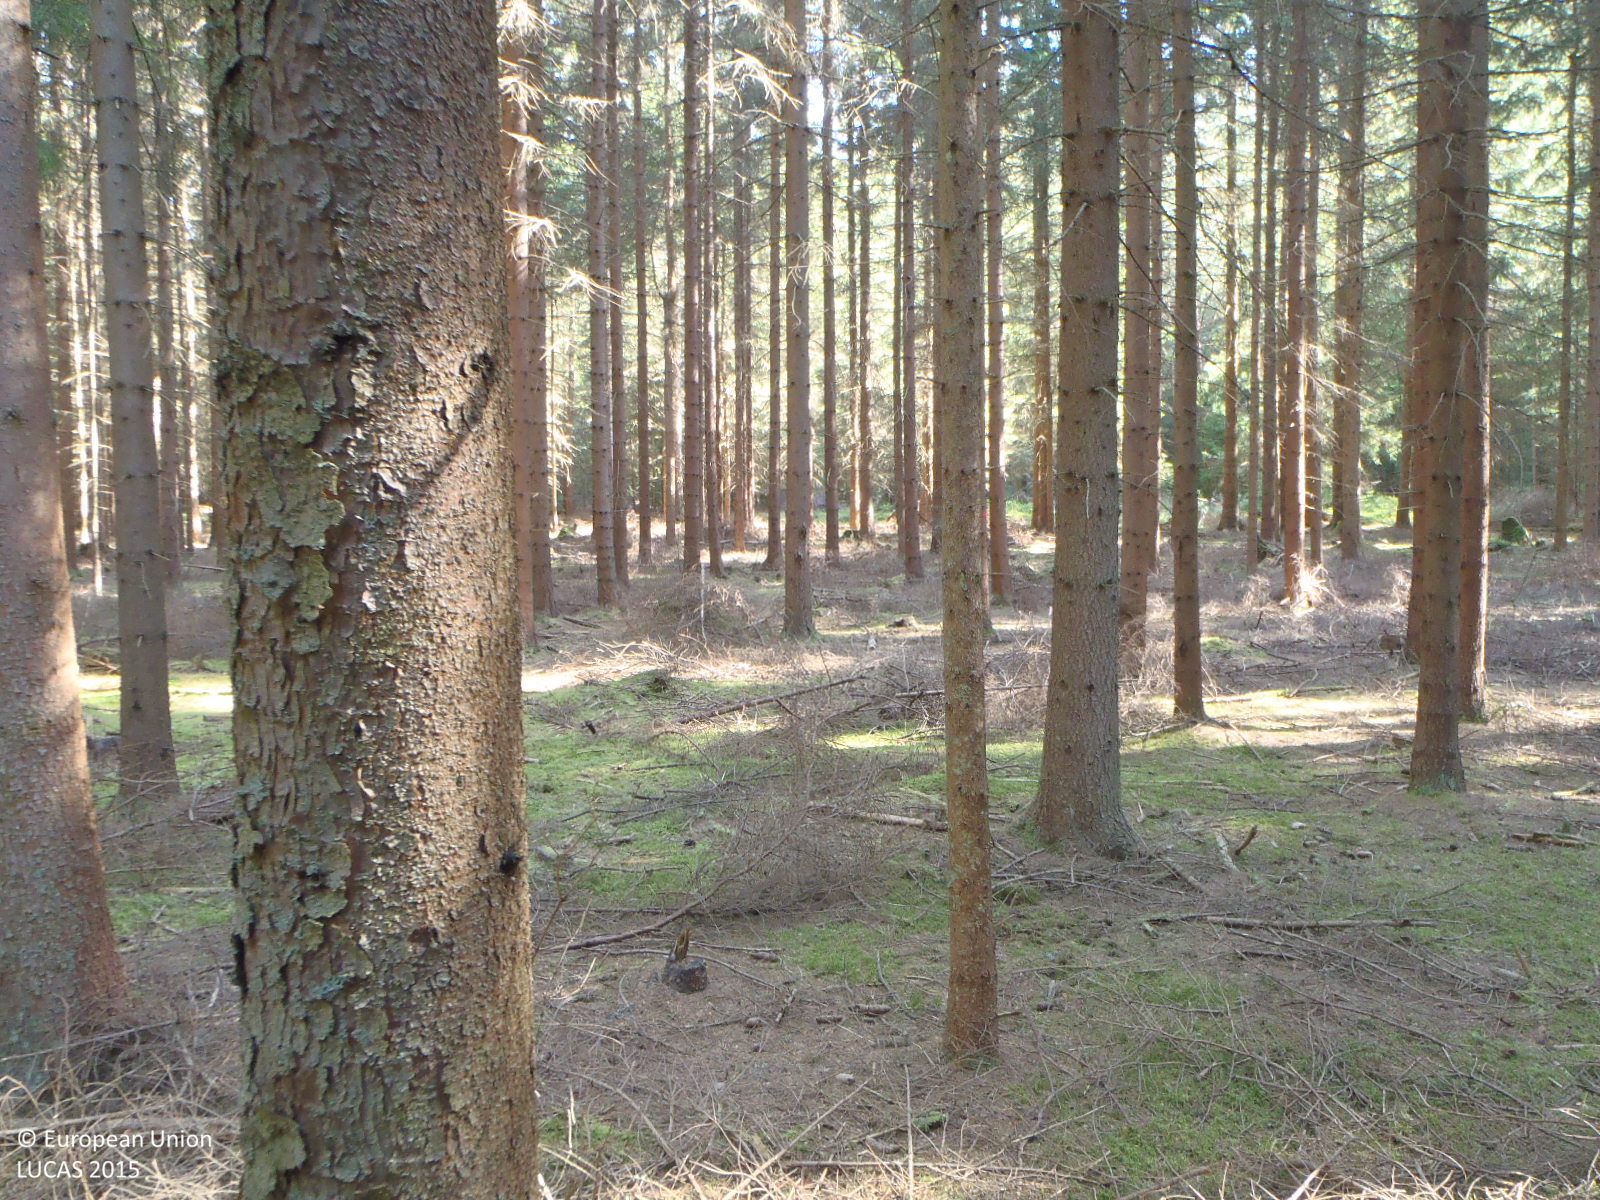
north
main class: Woodland
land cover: Spruce dominated coniferous woodland
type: hemiboreal forest and nemoral coniferous forest and mixed broadleaved-coniferous forest
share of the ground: > 75 %
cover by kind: coniferous forest trees 95 %, lichens and mosses 5 %
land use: Forestry
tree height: > 5 m
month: May
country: CZ
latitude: 49.0081
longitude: 15.0742
